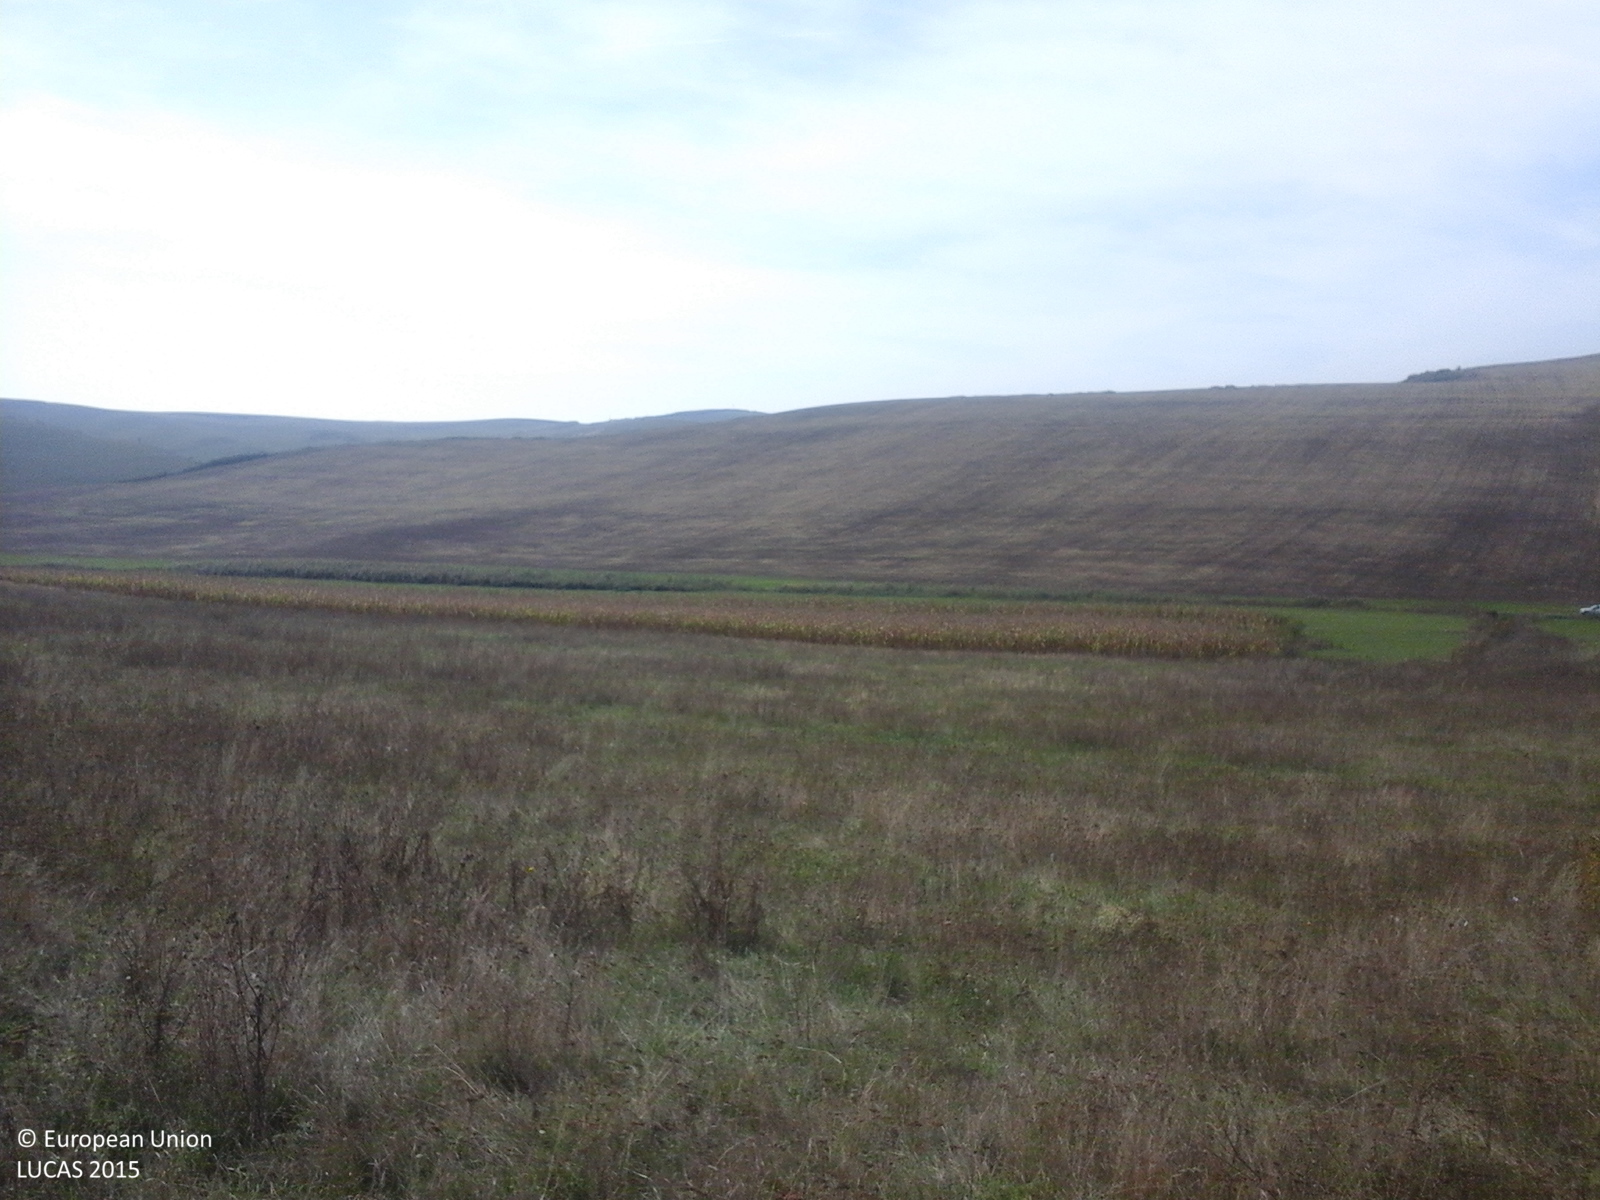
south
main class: Grassland
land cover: Grassland without tree/shrub cover
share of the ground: > 75 %
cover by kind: herbaceous plants 100 %
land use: Agriculture (excluding fallow land and kitchen gardens)
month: September
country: RO
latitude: 46.7792
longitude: 23.8410
